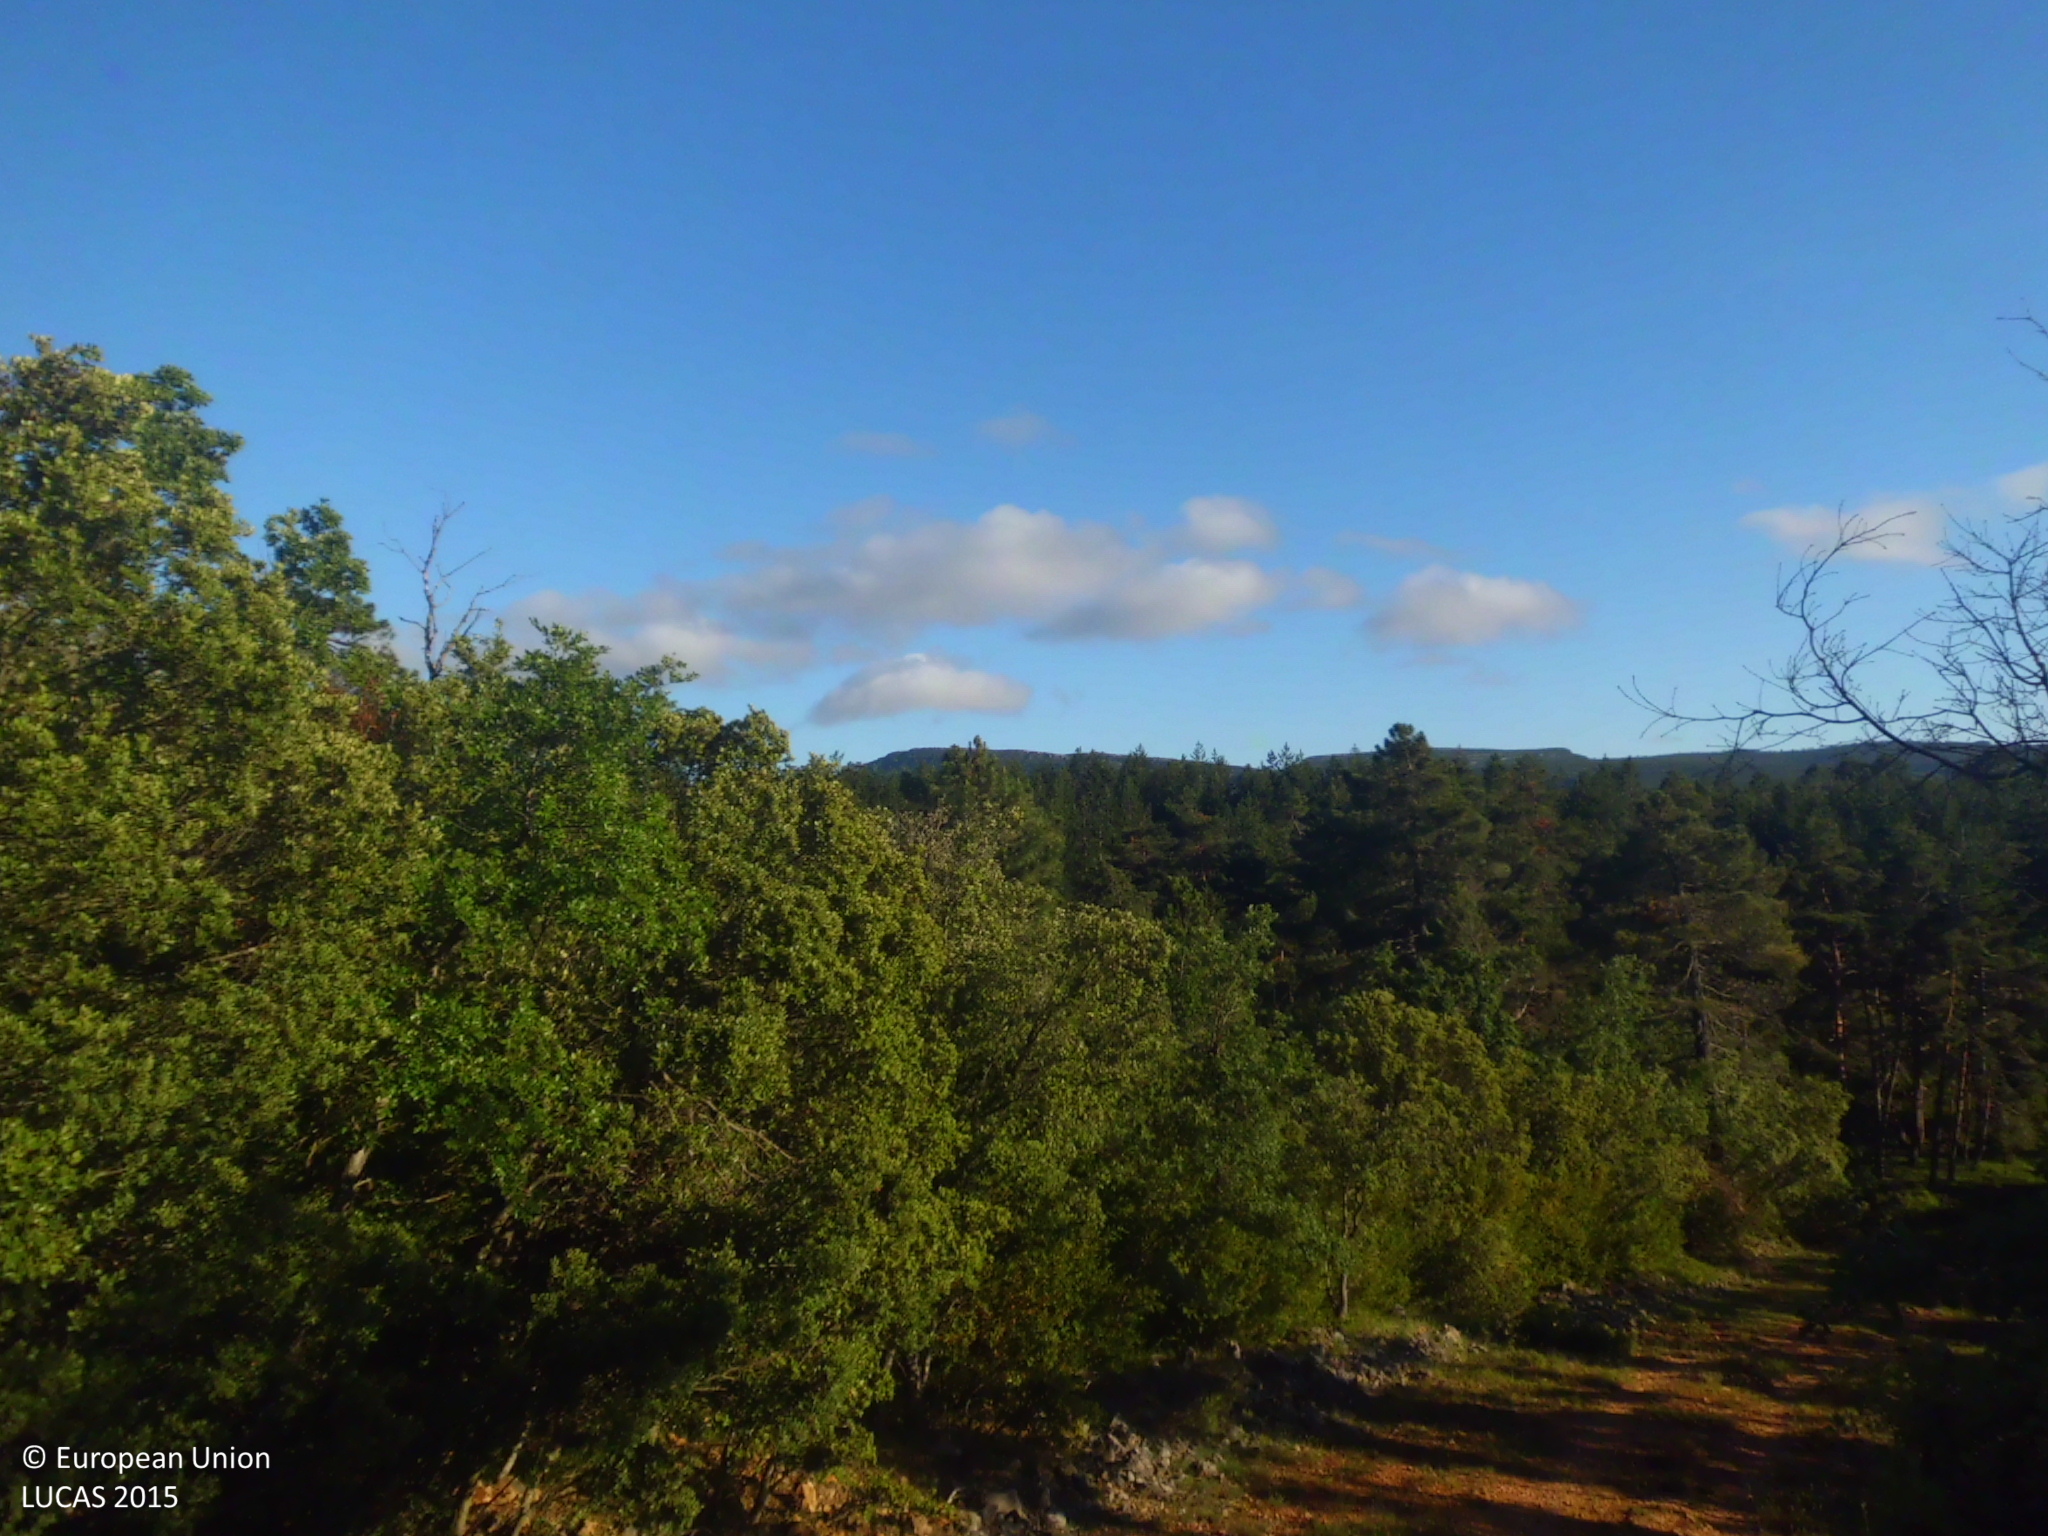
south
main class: Woodland
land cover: Broadleaved woodland
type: broadleaved evergreen forest
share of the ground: > 75 %
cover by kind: broadleaved forest trees 80 %, shrubs 20 %
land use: Forestry
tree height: > 5 m
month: June
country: ES
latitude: 42.7477
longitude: -3.3888
